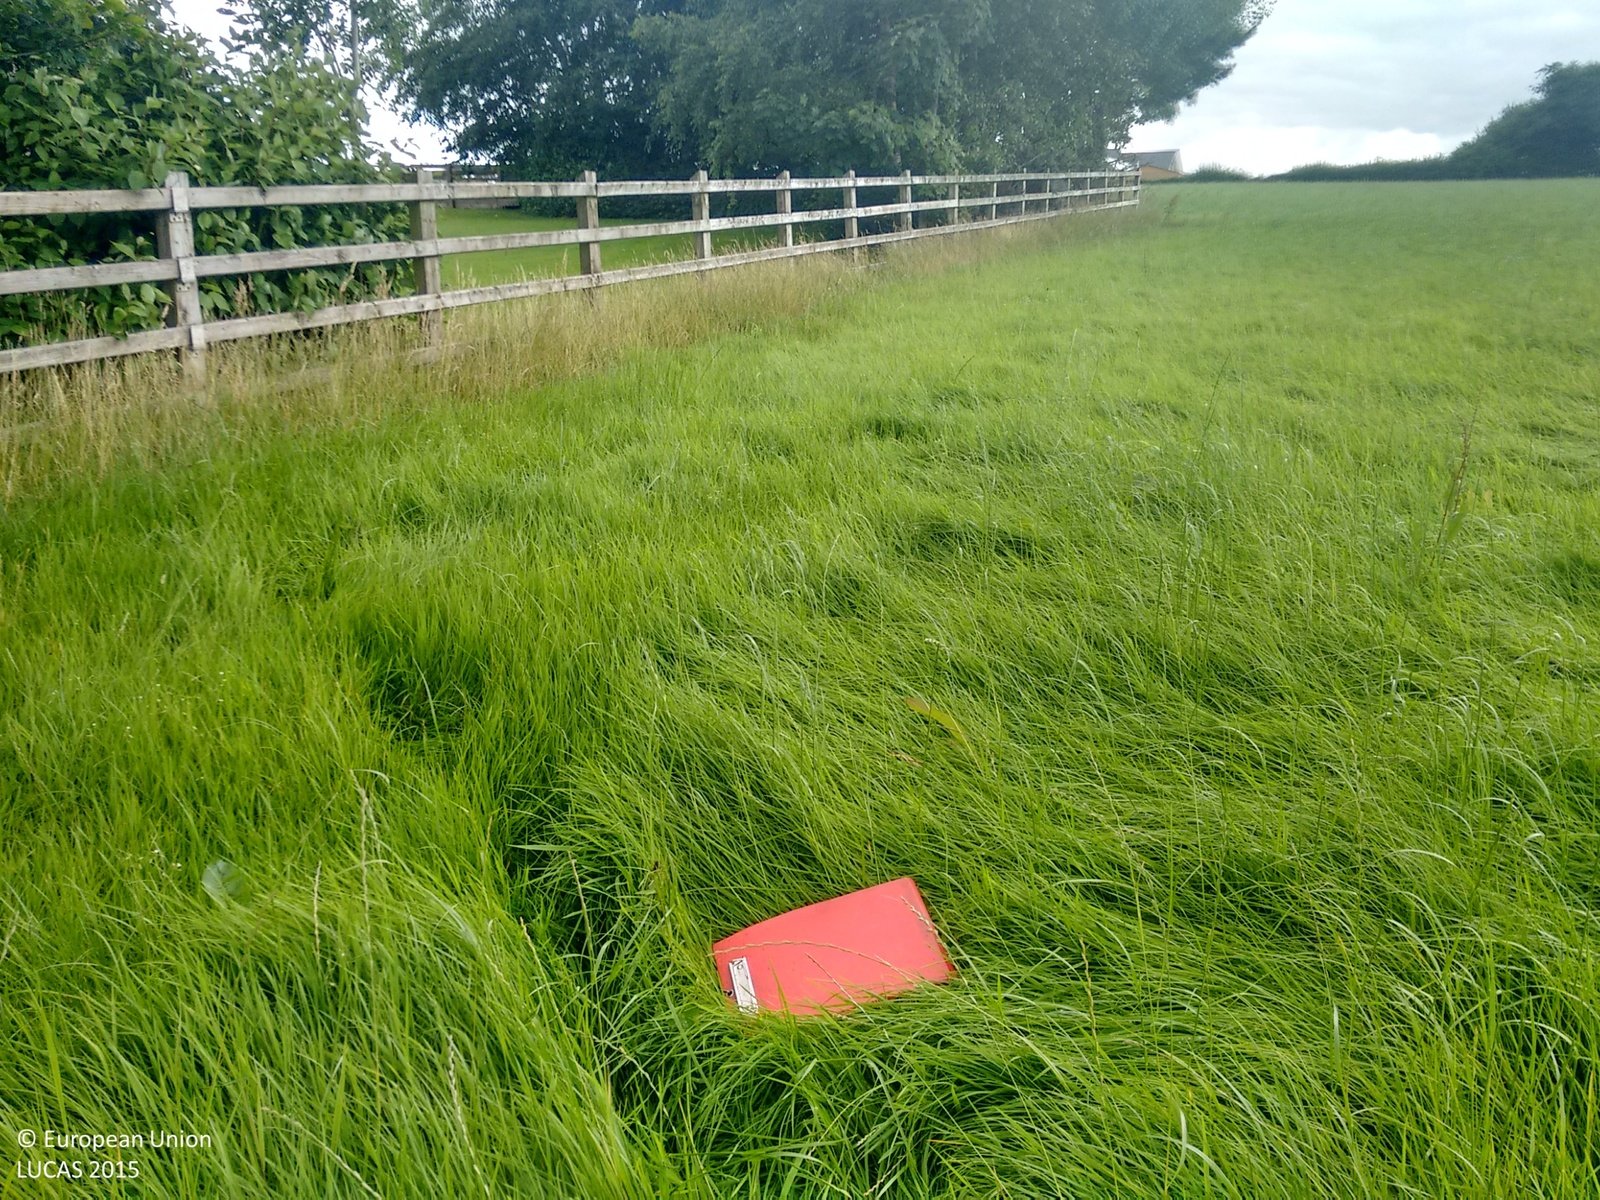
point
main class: Grassland
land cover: Grassland without tree/shrub cover
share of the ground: > 75 %
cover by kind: herbaceous plants 100 %
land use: Agriculture (excluding fallow land and kitchen gardens)
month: August
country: GB
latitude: 54.3280
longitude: -6.6914
